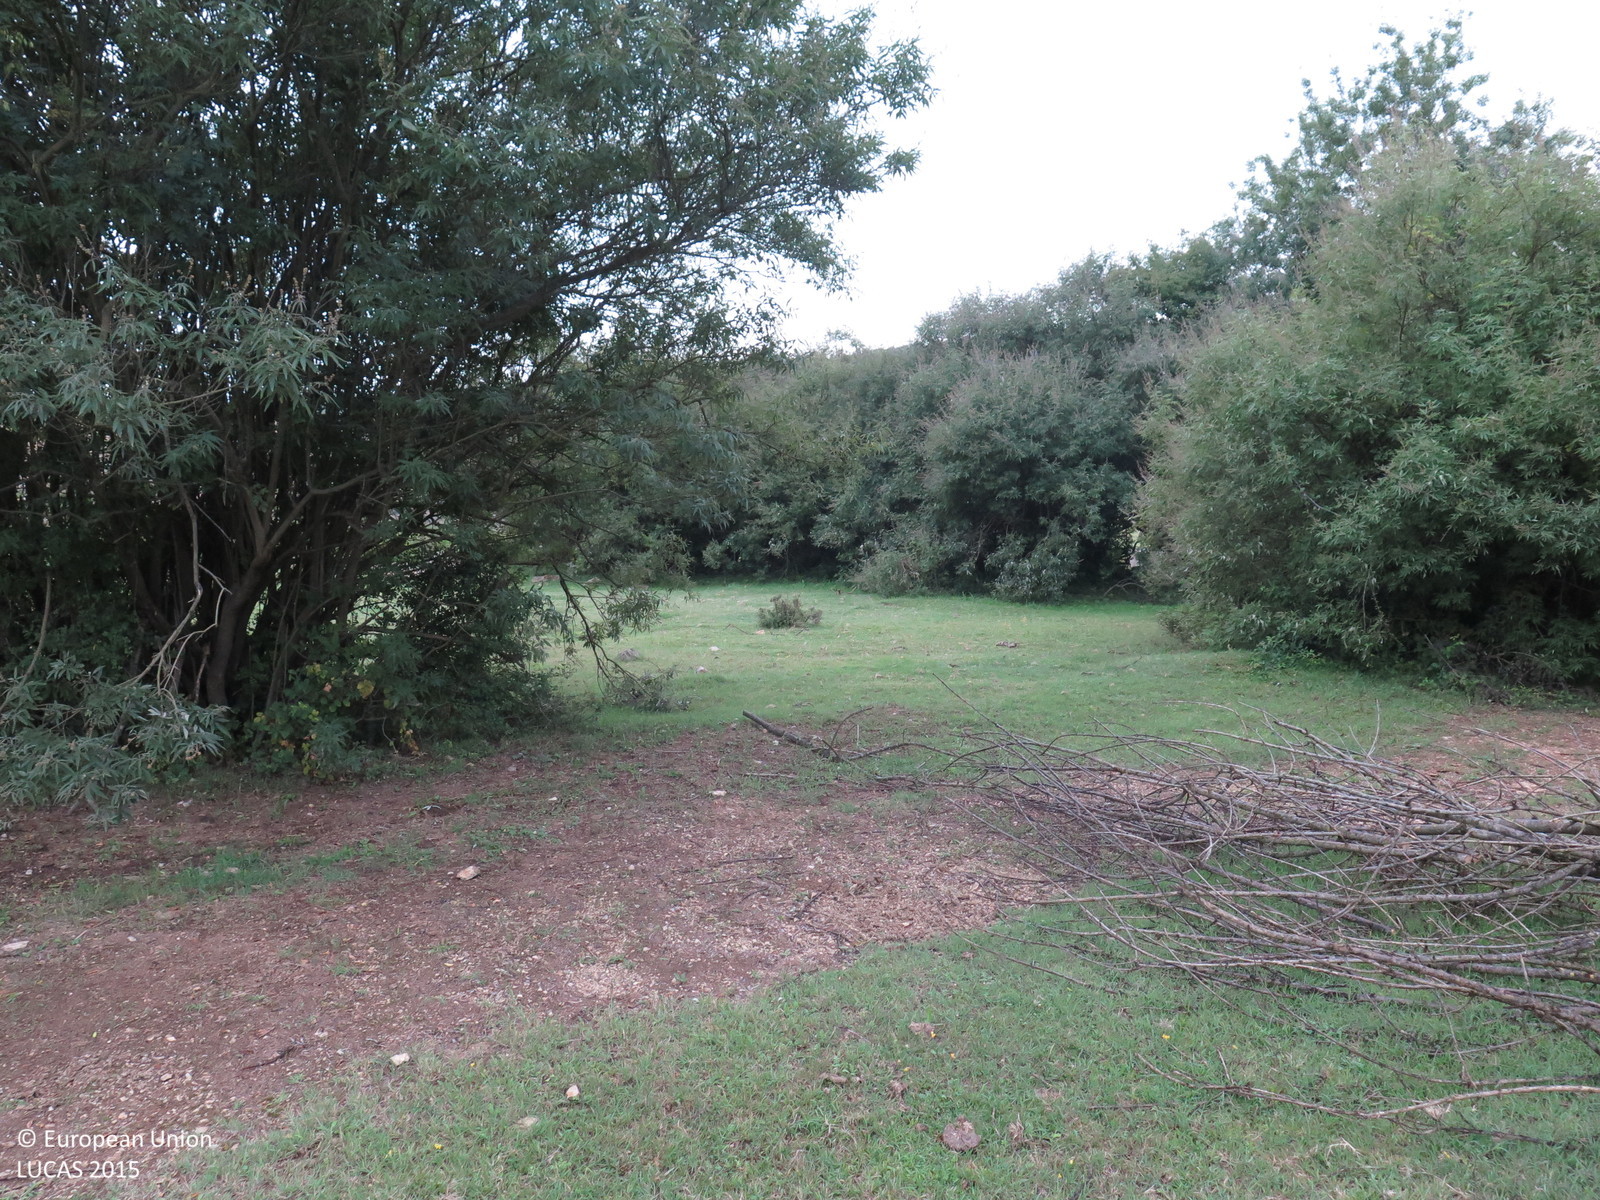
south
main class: Grassland
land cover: Grassland with sparse tree/shrub cover
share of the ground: > 75 %
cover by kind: herbaceous plants 95 %, broadleaved forest trees 5 %
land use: Water supply and treatment
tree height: > 5 m
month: August
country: HR
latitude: 45.0812
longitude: 14.5551
